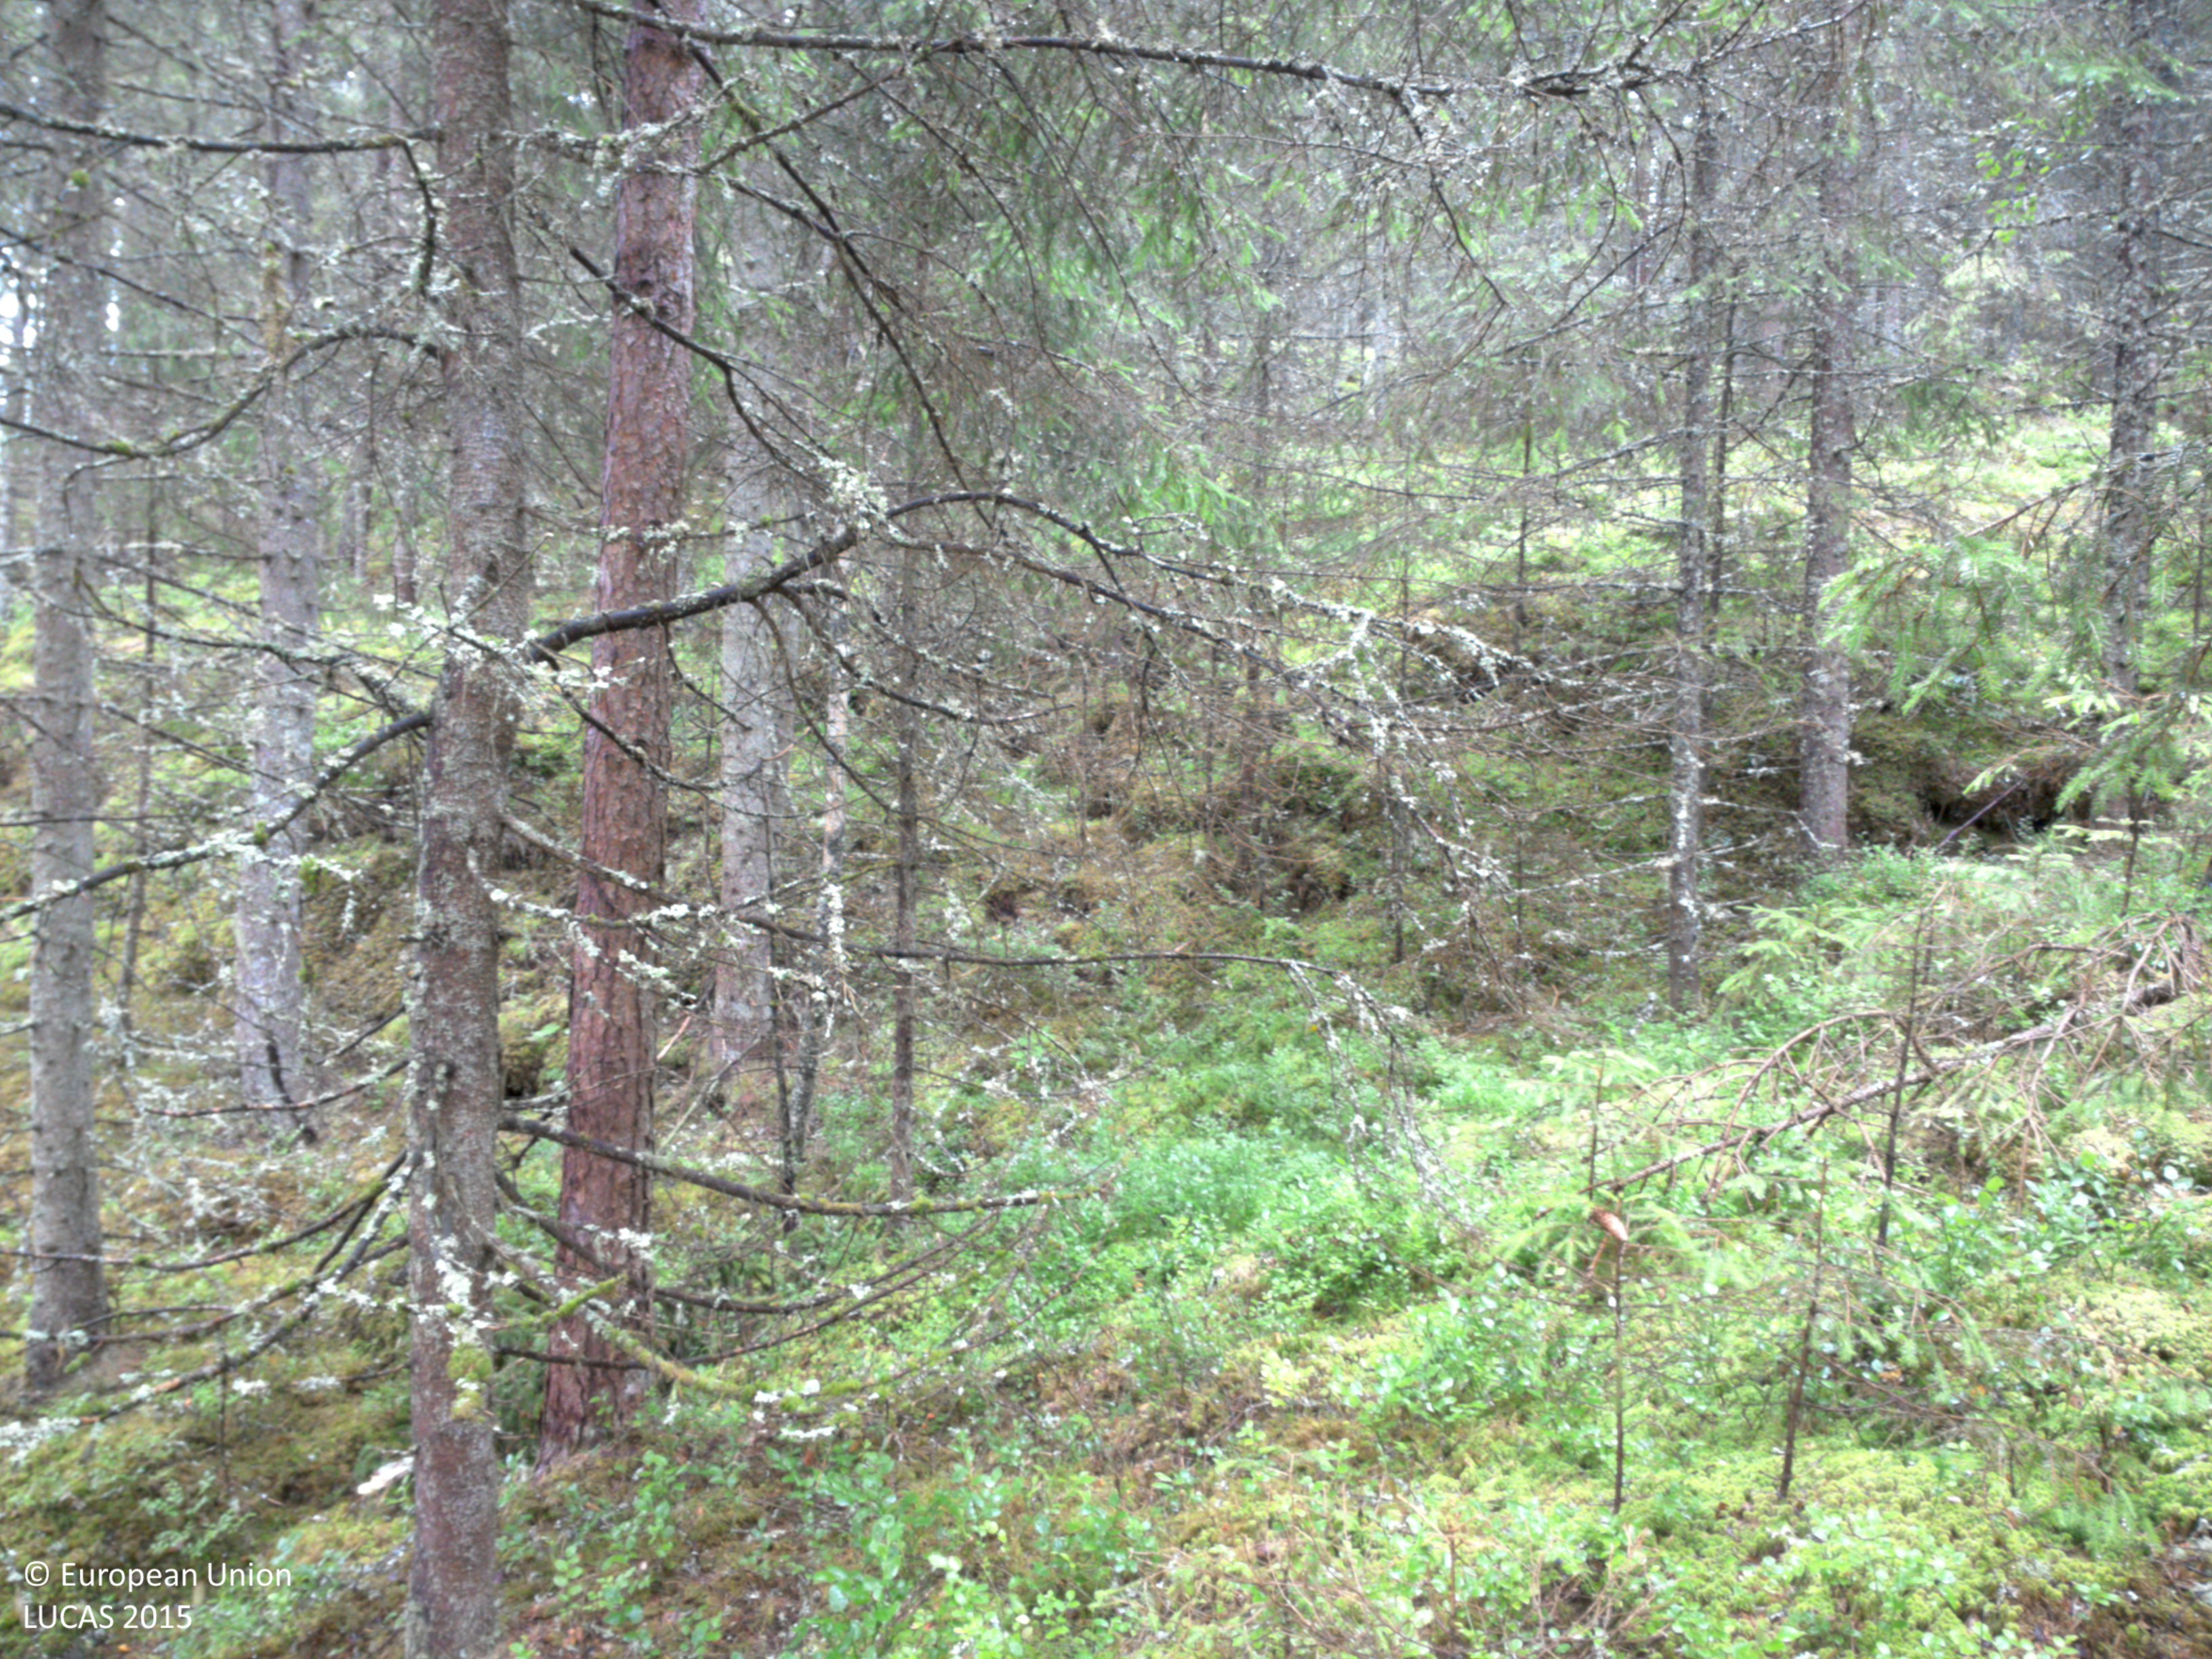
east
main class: Woodland
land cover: Spruce dominated coniferous woodland
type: boreal forest
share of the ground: 50 - 75 %
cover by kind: coniferous forest trees 70 %, lichens and mosses 20 %, shrubs 10 %
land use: Forestry
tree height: > 5 m
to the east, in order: Spruce dominated coniferous woodland; Lichens and moss; Rivers and streams; Lichens and moss; Spruce dominated mixed woodland
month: July
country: SE
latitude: 58.6957
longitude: 11.6012
